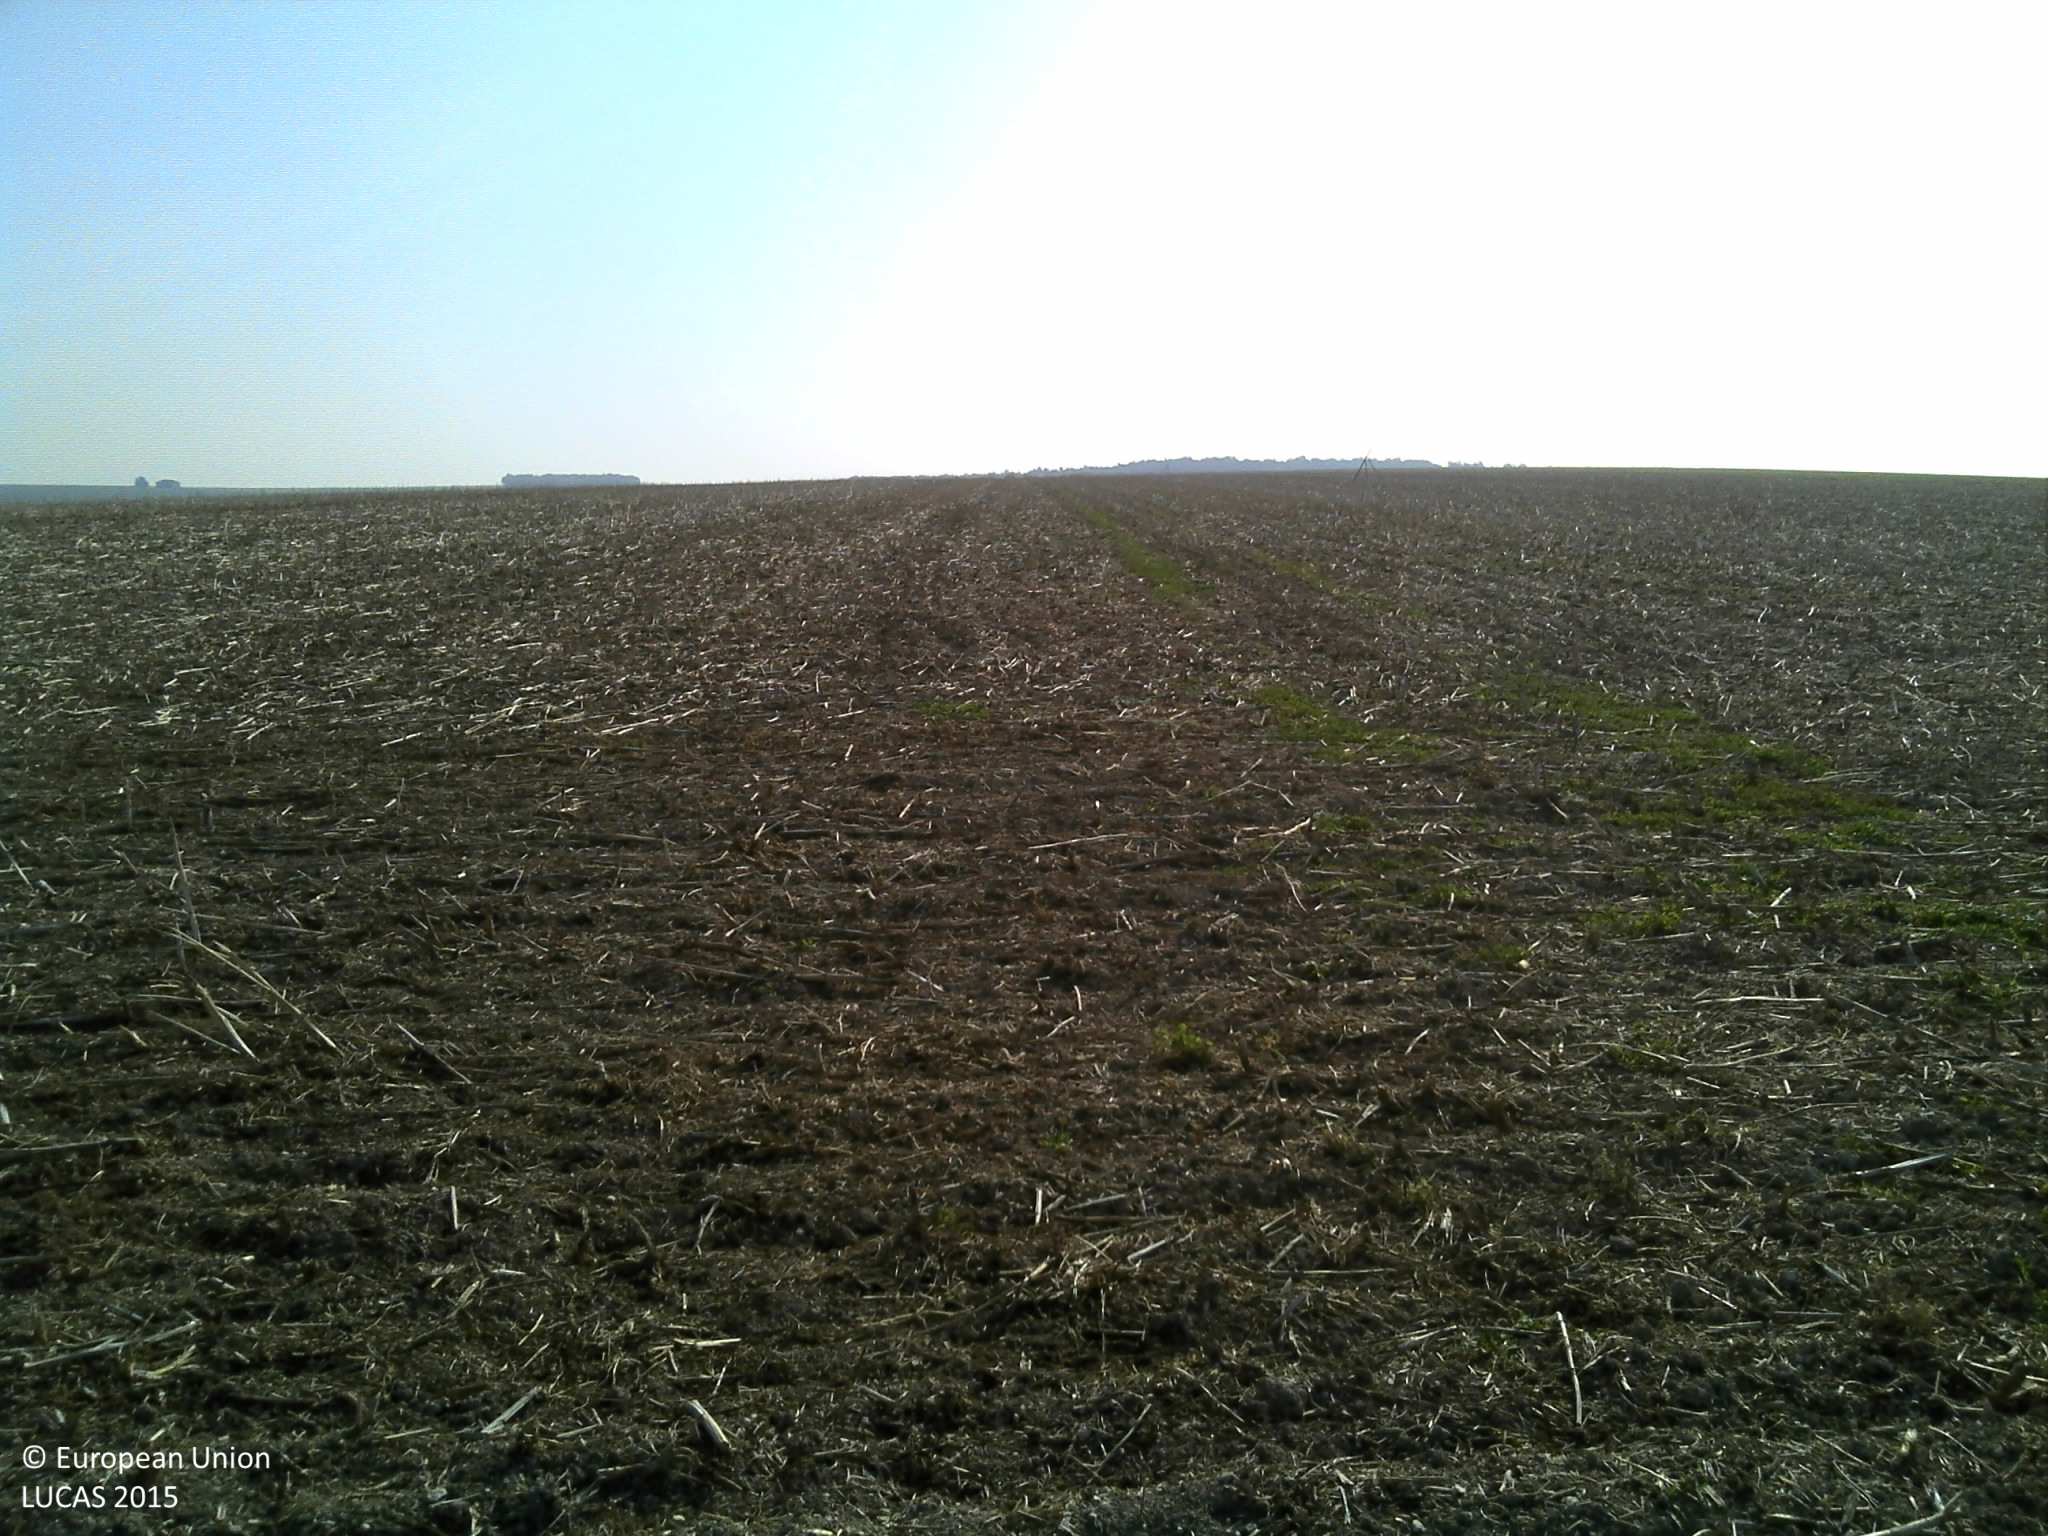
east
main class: Cropland
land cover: Rape and turnip rape
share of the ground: > 75 %
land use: Agriculture (excluding fallow land and kitchen gardens)
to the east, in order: Rape and turnip rape
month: August
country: FR
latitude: 48.9376
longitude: 4.5772
